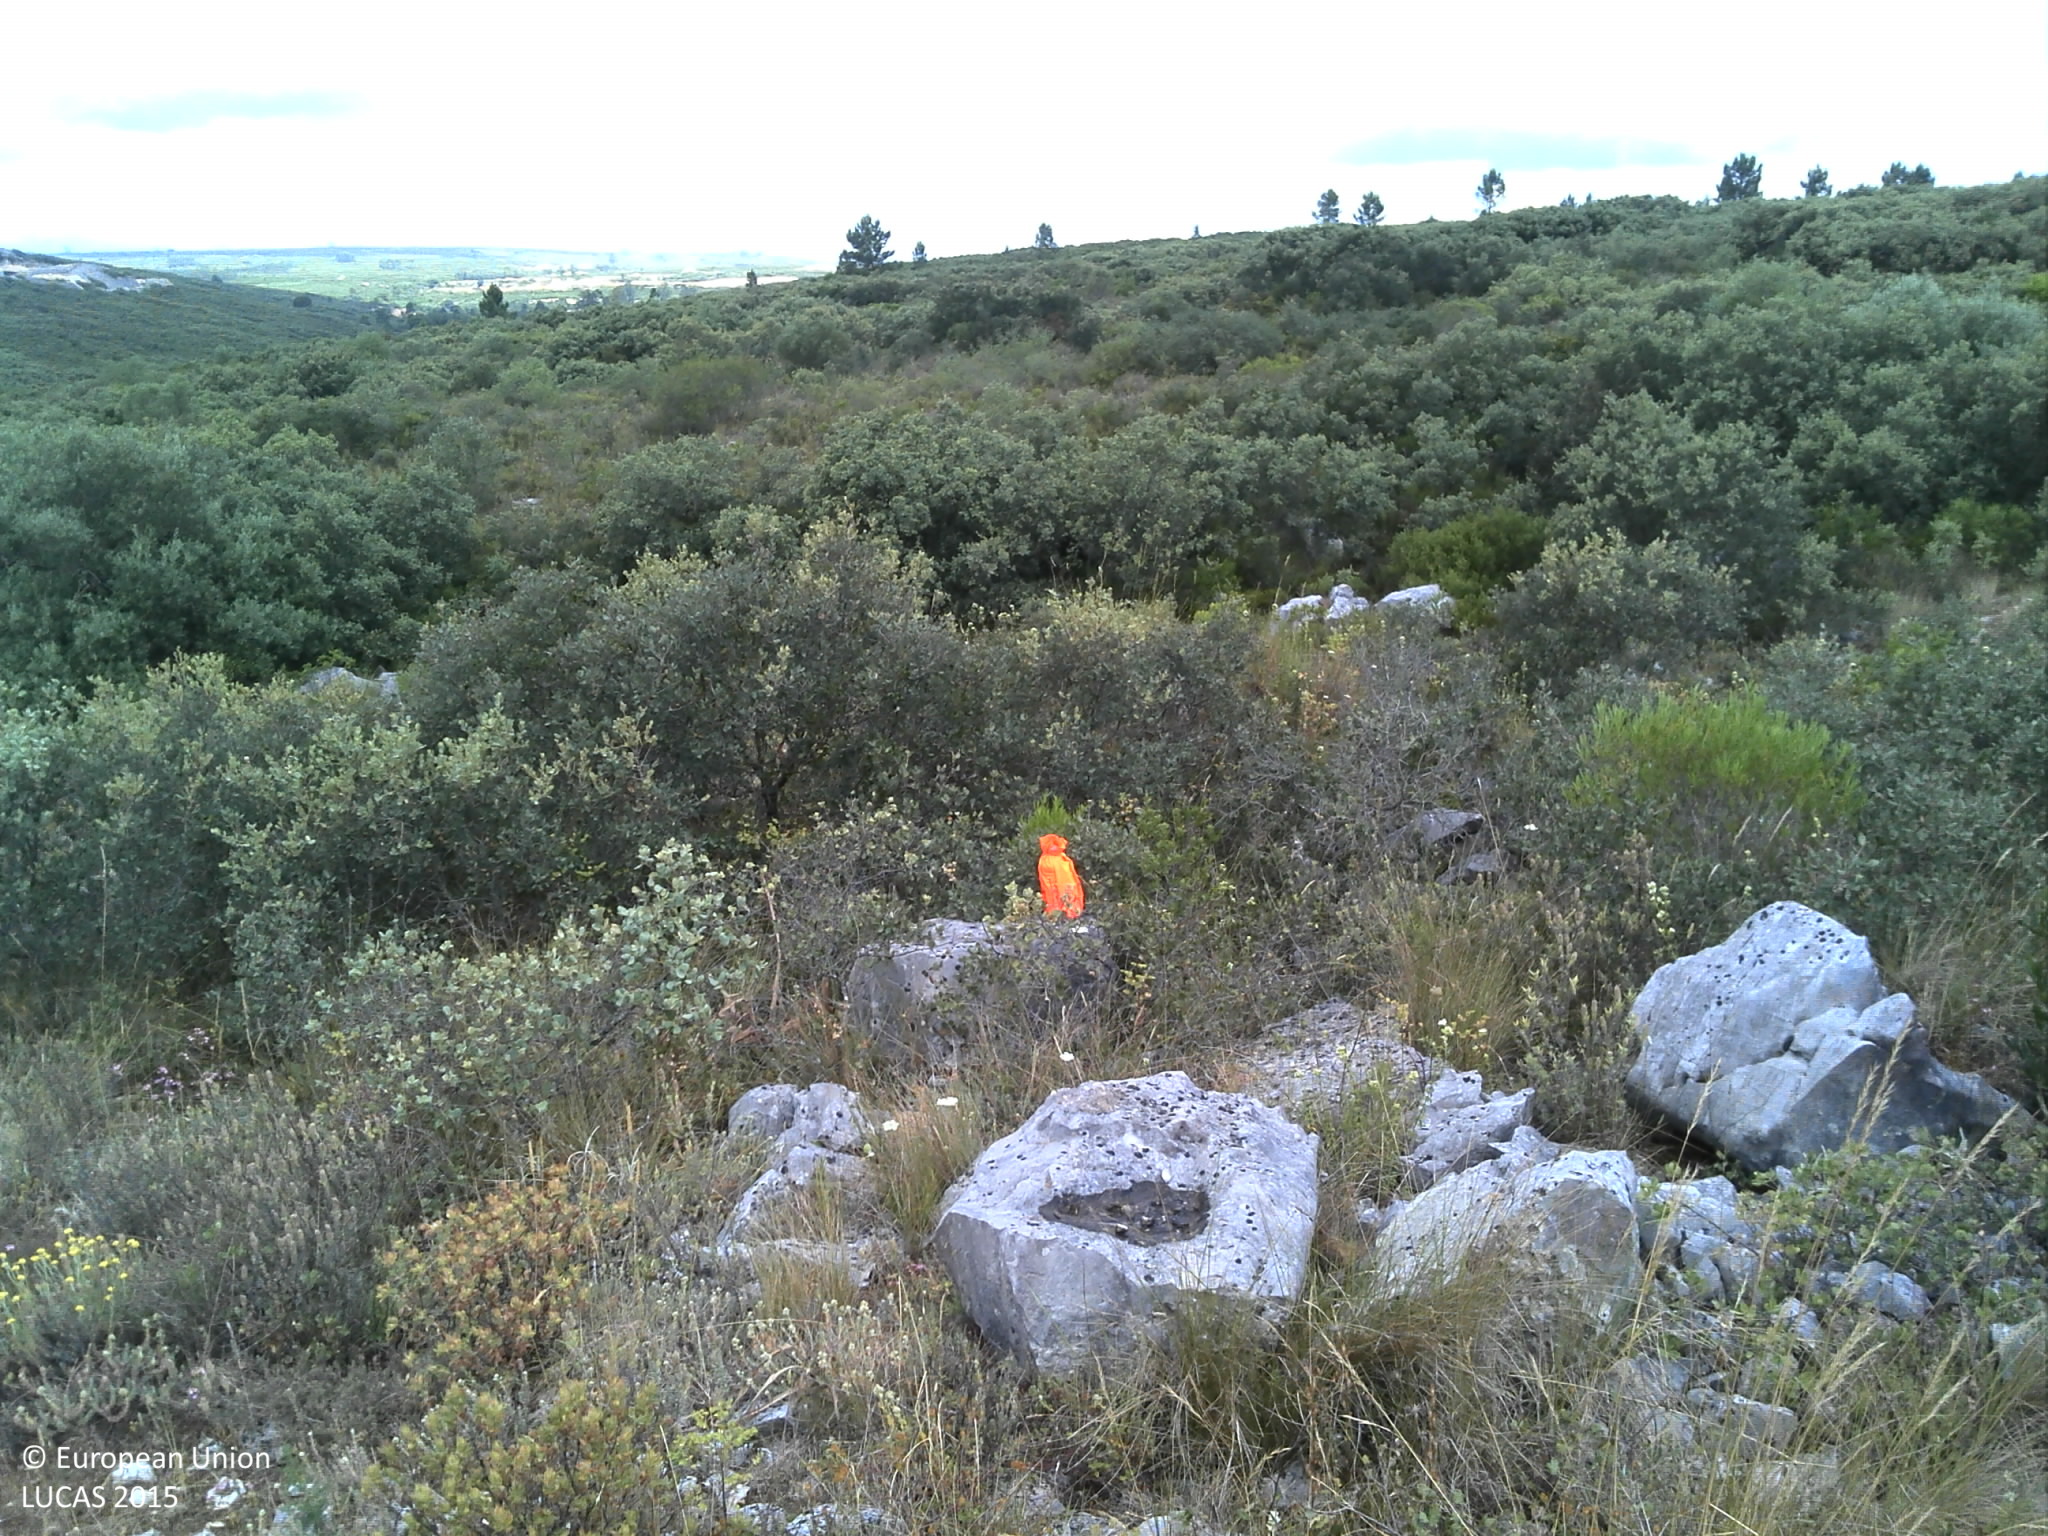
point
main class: Shrubland
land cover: Shrubland with sparse tree cover
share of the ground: 25 - 50 %
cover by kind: shrubs 50 %, unconsolidated bare surface 30 %, herbaceous plants 10 %, broadleaved forest trees 5 %, consolidated bare surface 5 %
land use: Abandoned areas
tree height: < 5 m
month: June
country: PT
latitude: 39.4671
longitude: -8.8059
